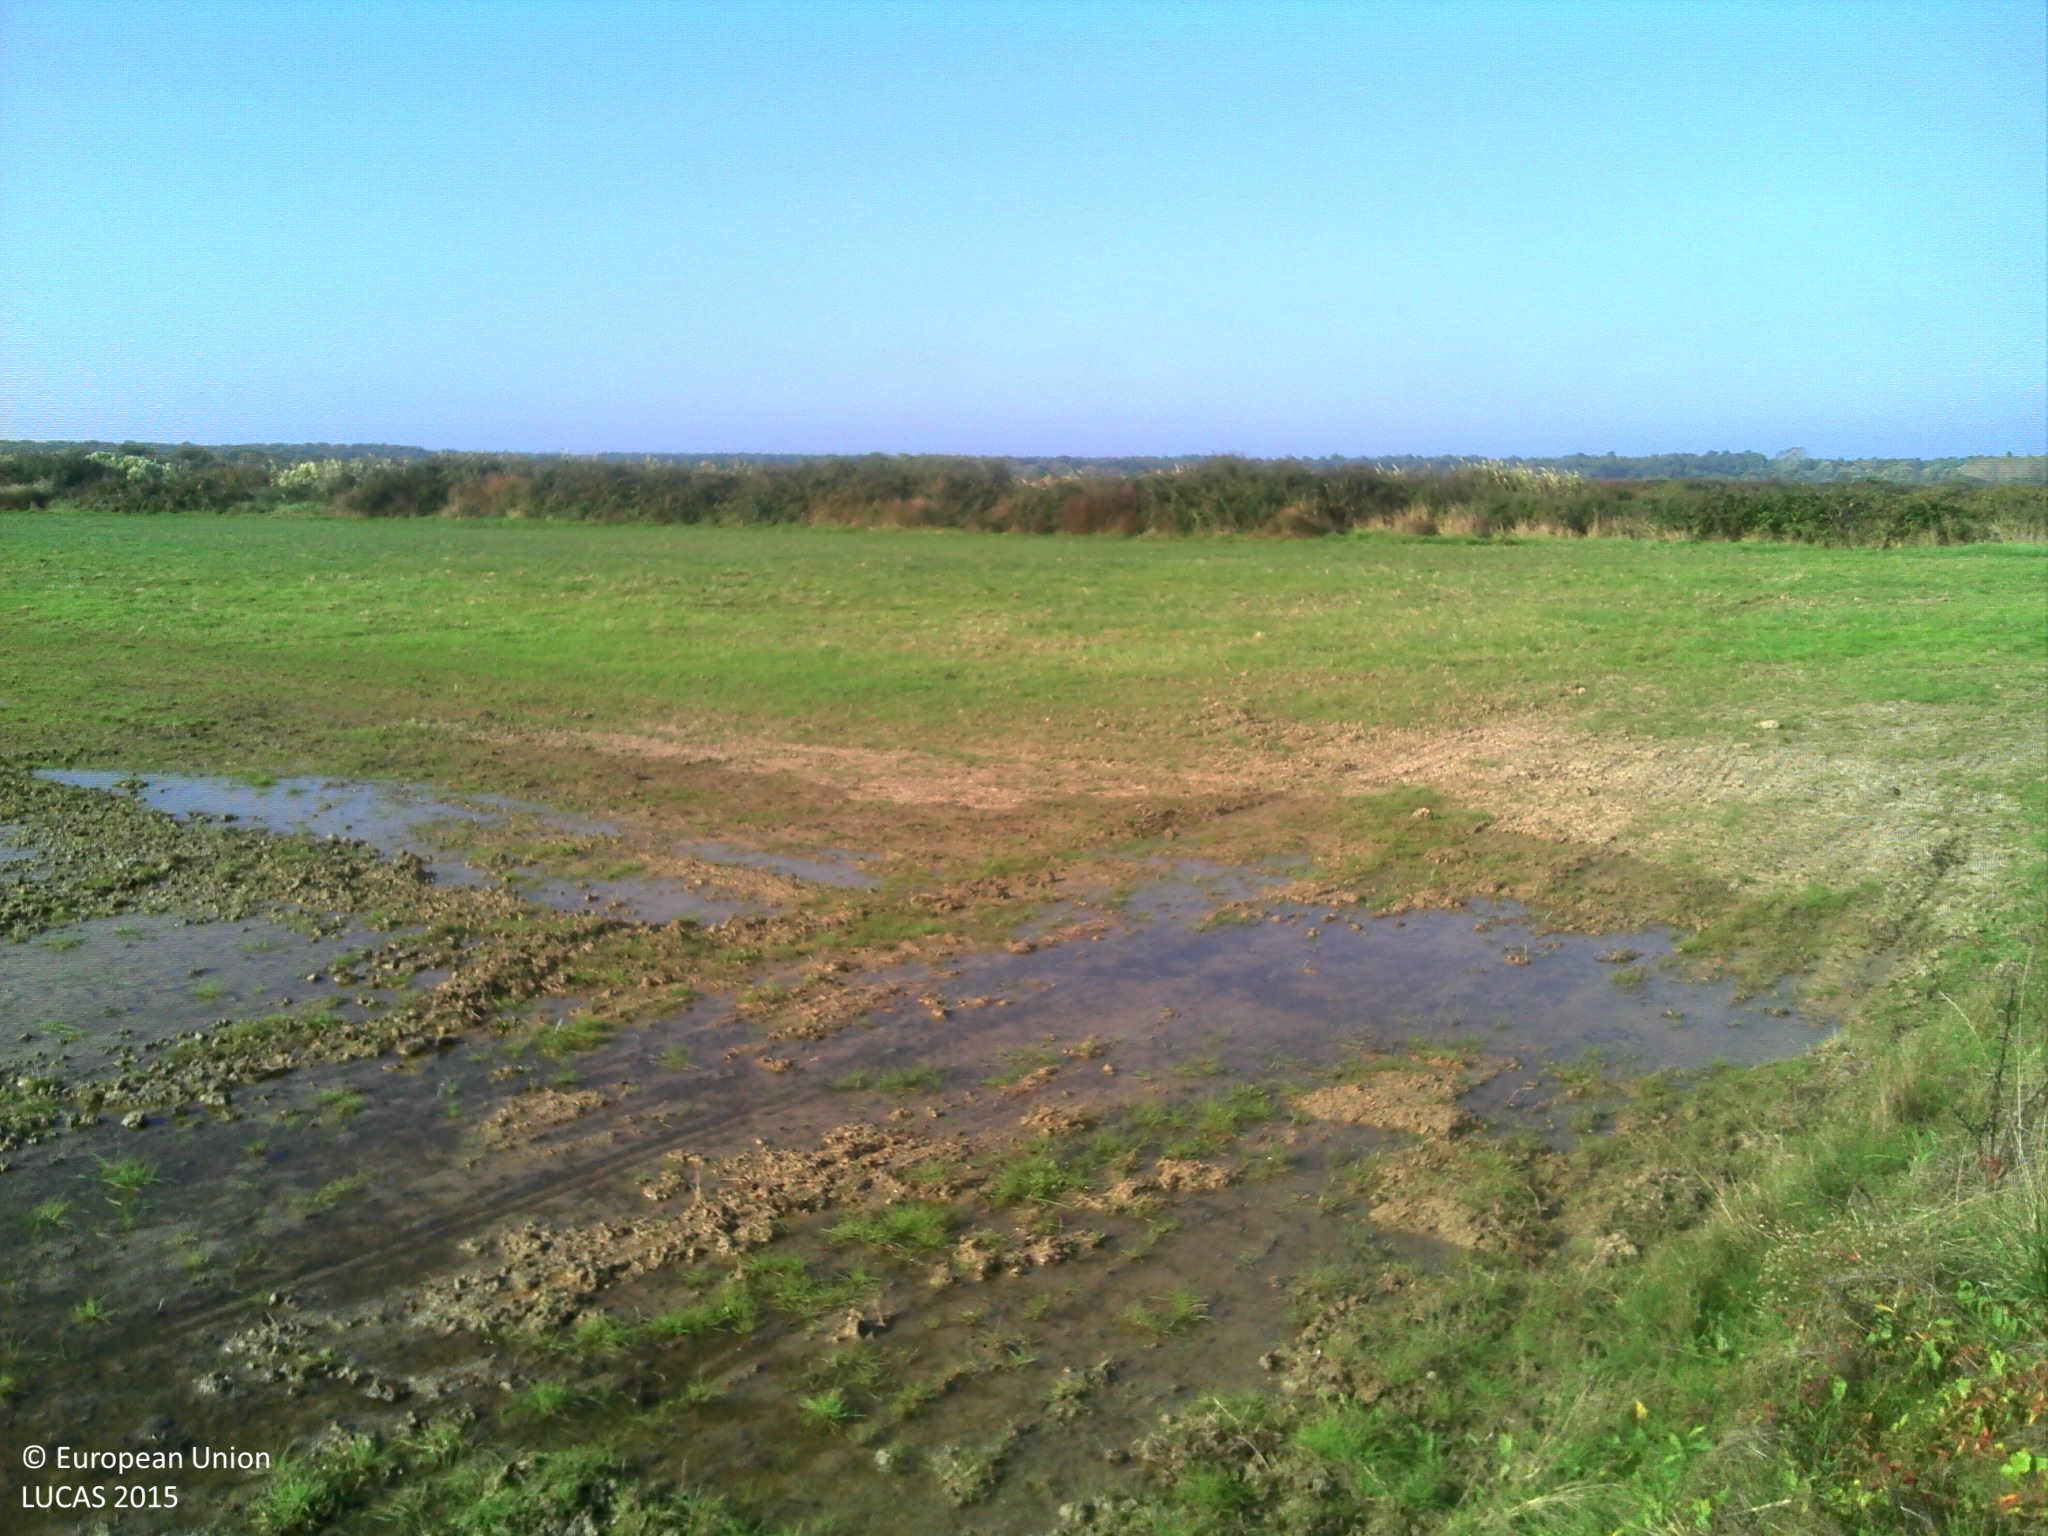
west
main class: Grassland
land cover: Spontaneously vegetated surfaces
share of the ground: > 75 %
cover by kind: herbaceous plants 100 %
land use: Agriculture (excluding fallow land and kitchen gardens)
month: October
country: FR
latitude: 45.4636
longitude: -1.0902
